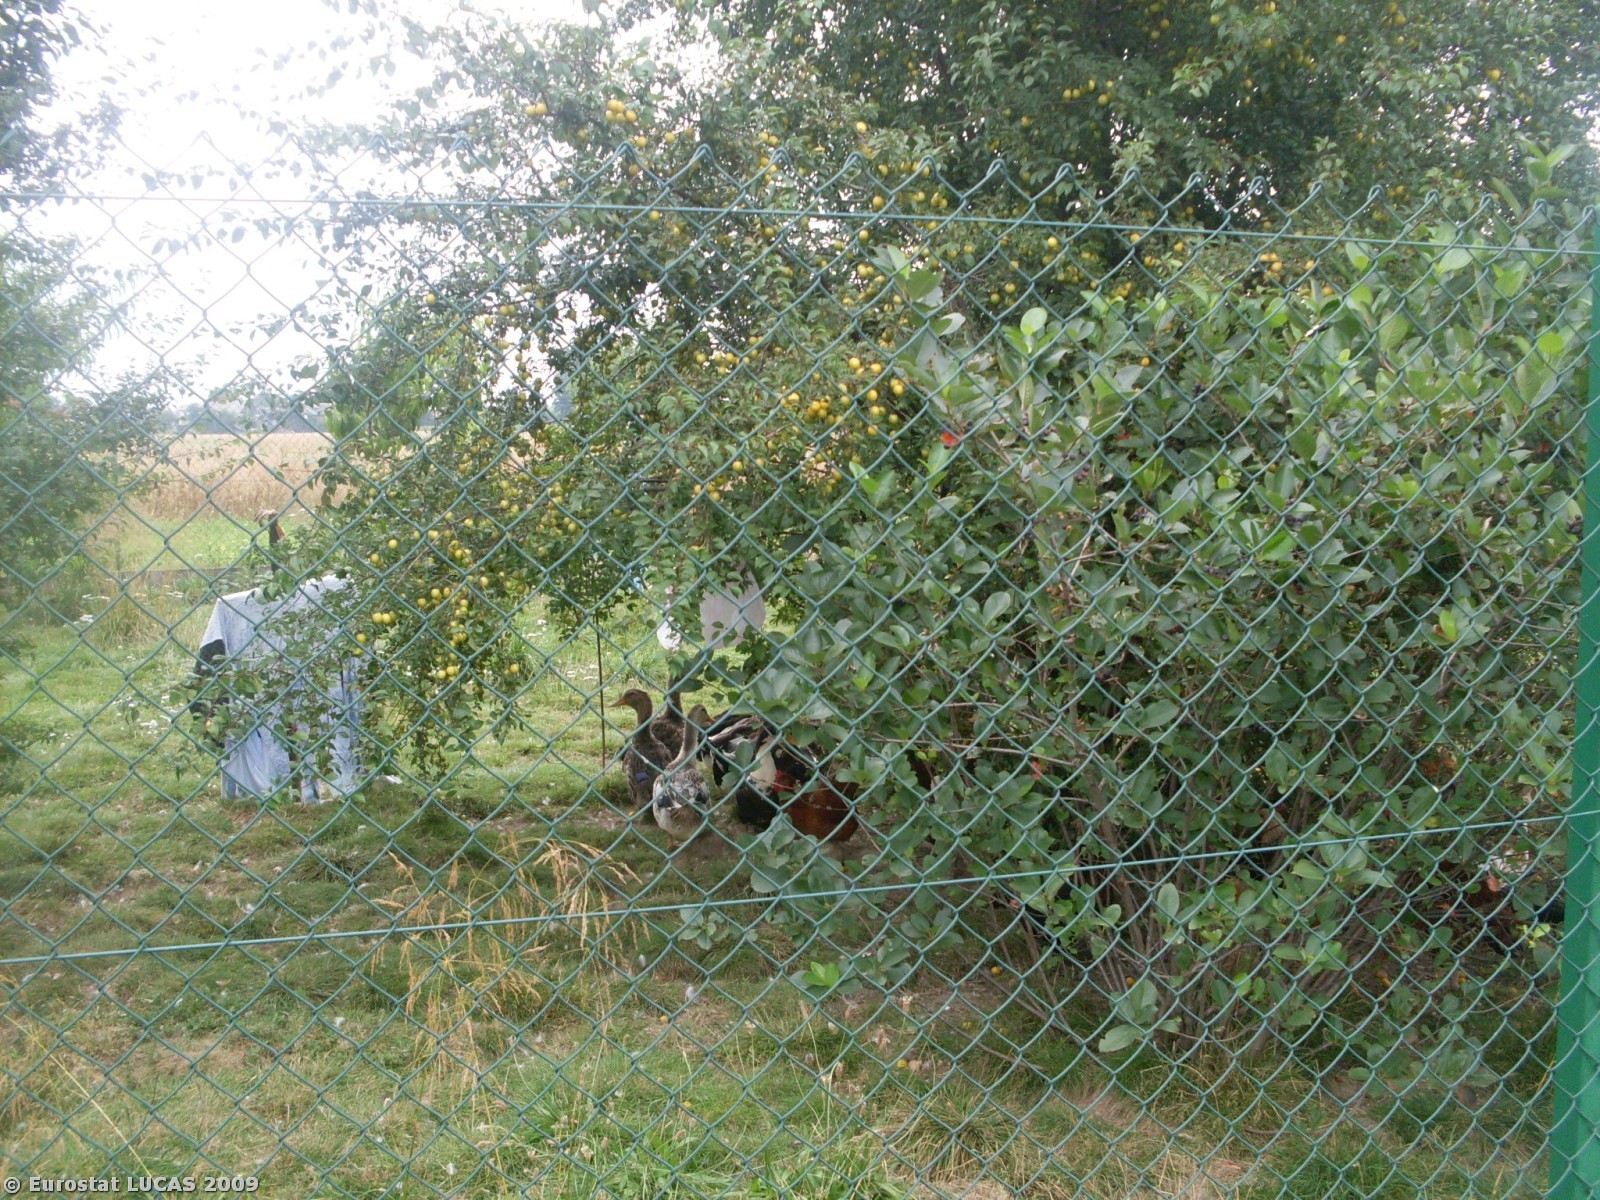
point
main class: Cropland
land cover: Other fruit trees and berries
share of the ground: 50 - 75 %
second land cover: Grassland with sparse tree/shrub cover
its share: > 75 %
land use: Agriculture (excluding fallow land and kitchen gardens)
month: August
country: PL
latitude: 50.0781
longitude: 20.7020
